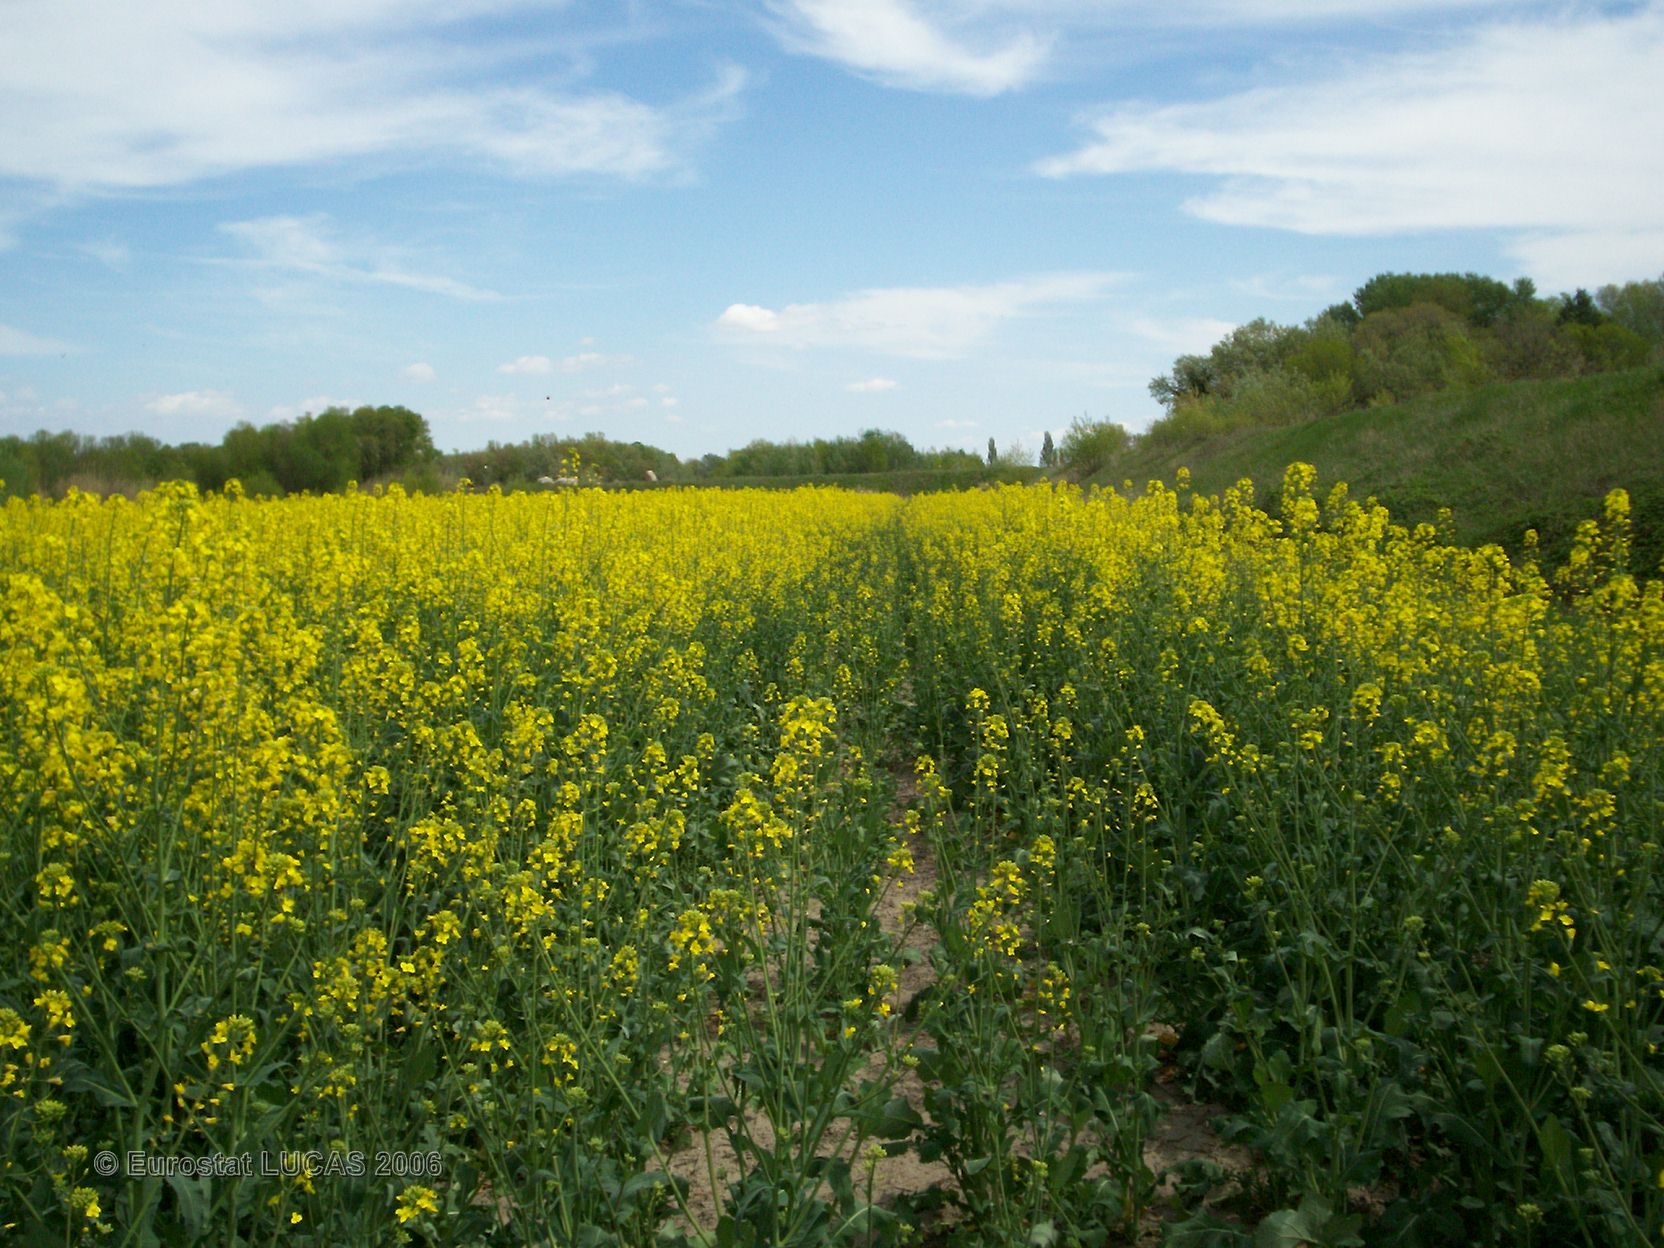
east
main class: Cropland
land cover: Rape and turnip rape
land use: Agriculture (excluding fallow land and kitchen gardens)
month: April
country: FR
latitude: 43.7372
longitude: 5.2786
